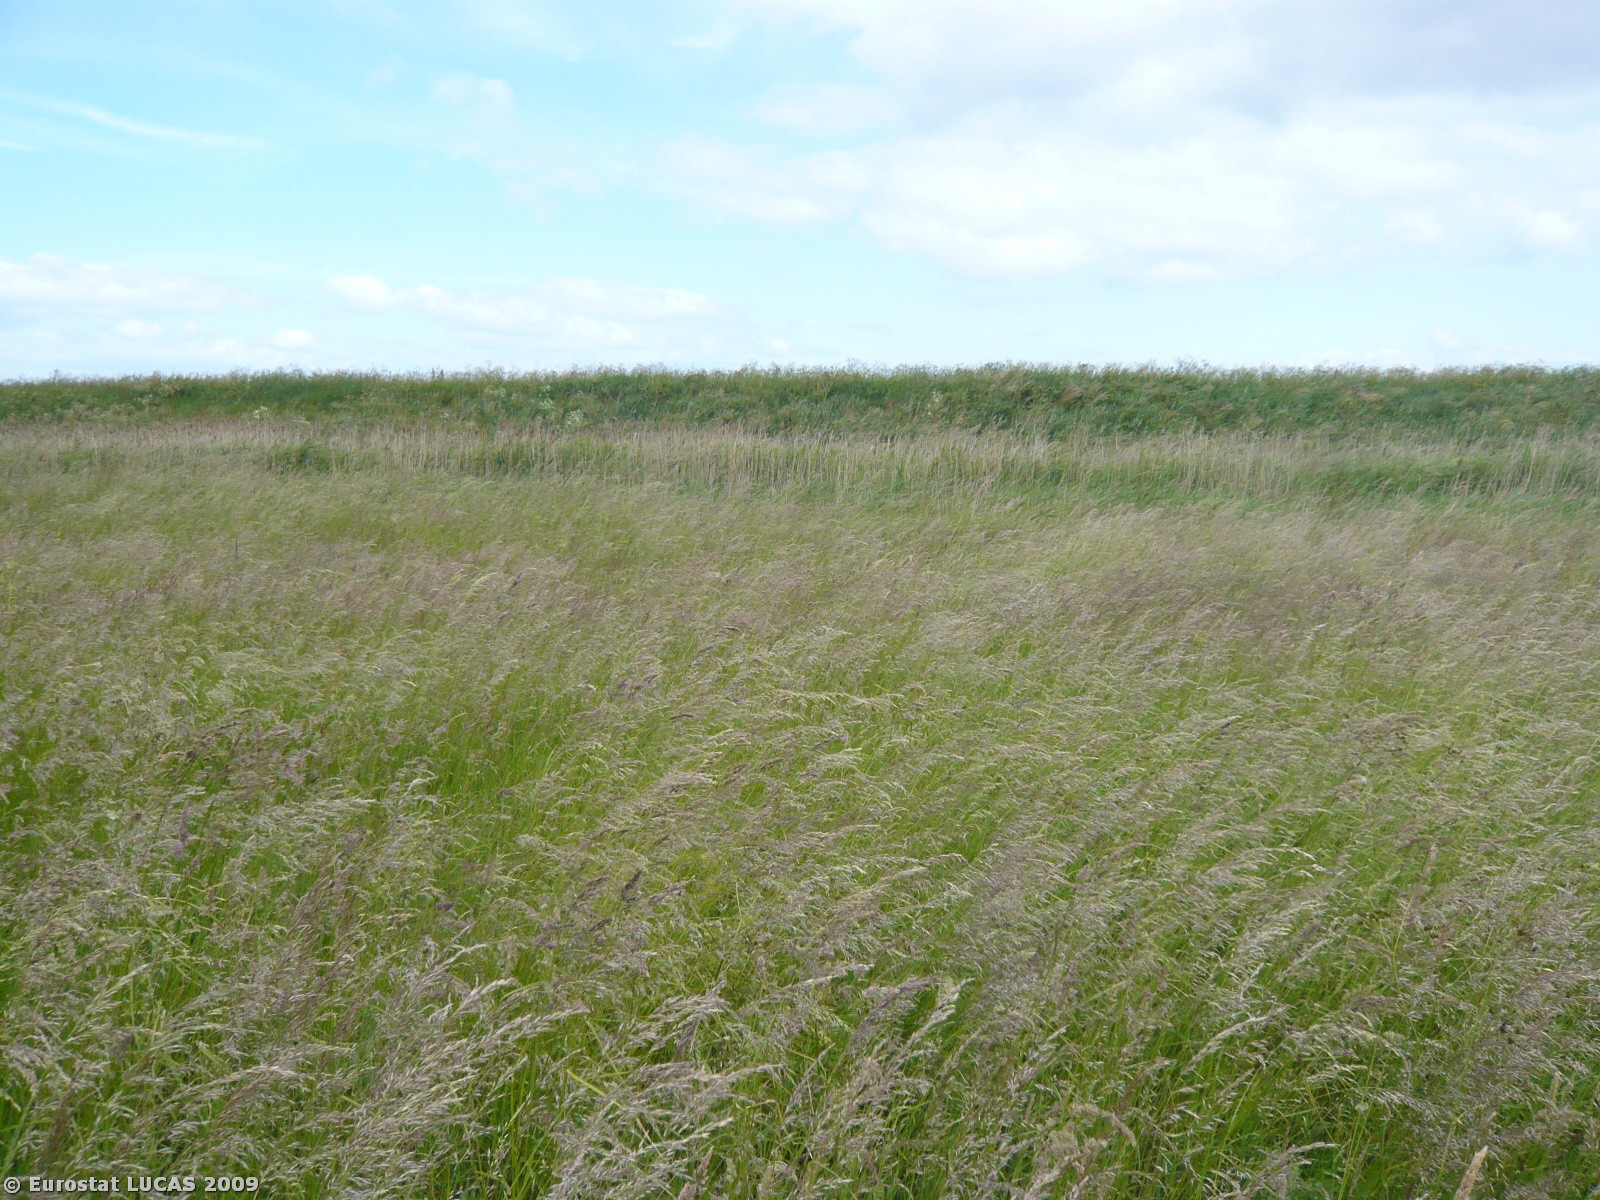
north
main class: Grassland
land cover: Grassland without tree/shrub cover
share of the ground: > 75 %
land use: Fallow land
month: June
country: DK
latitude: 54.9597
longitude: 11.2016
